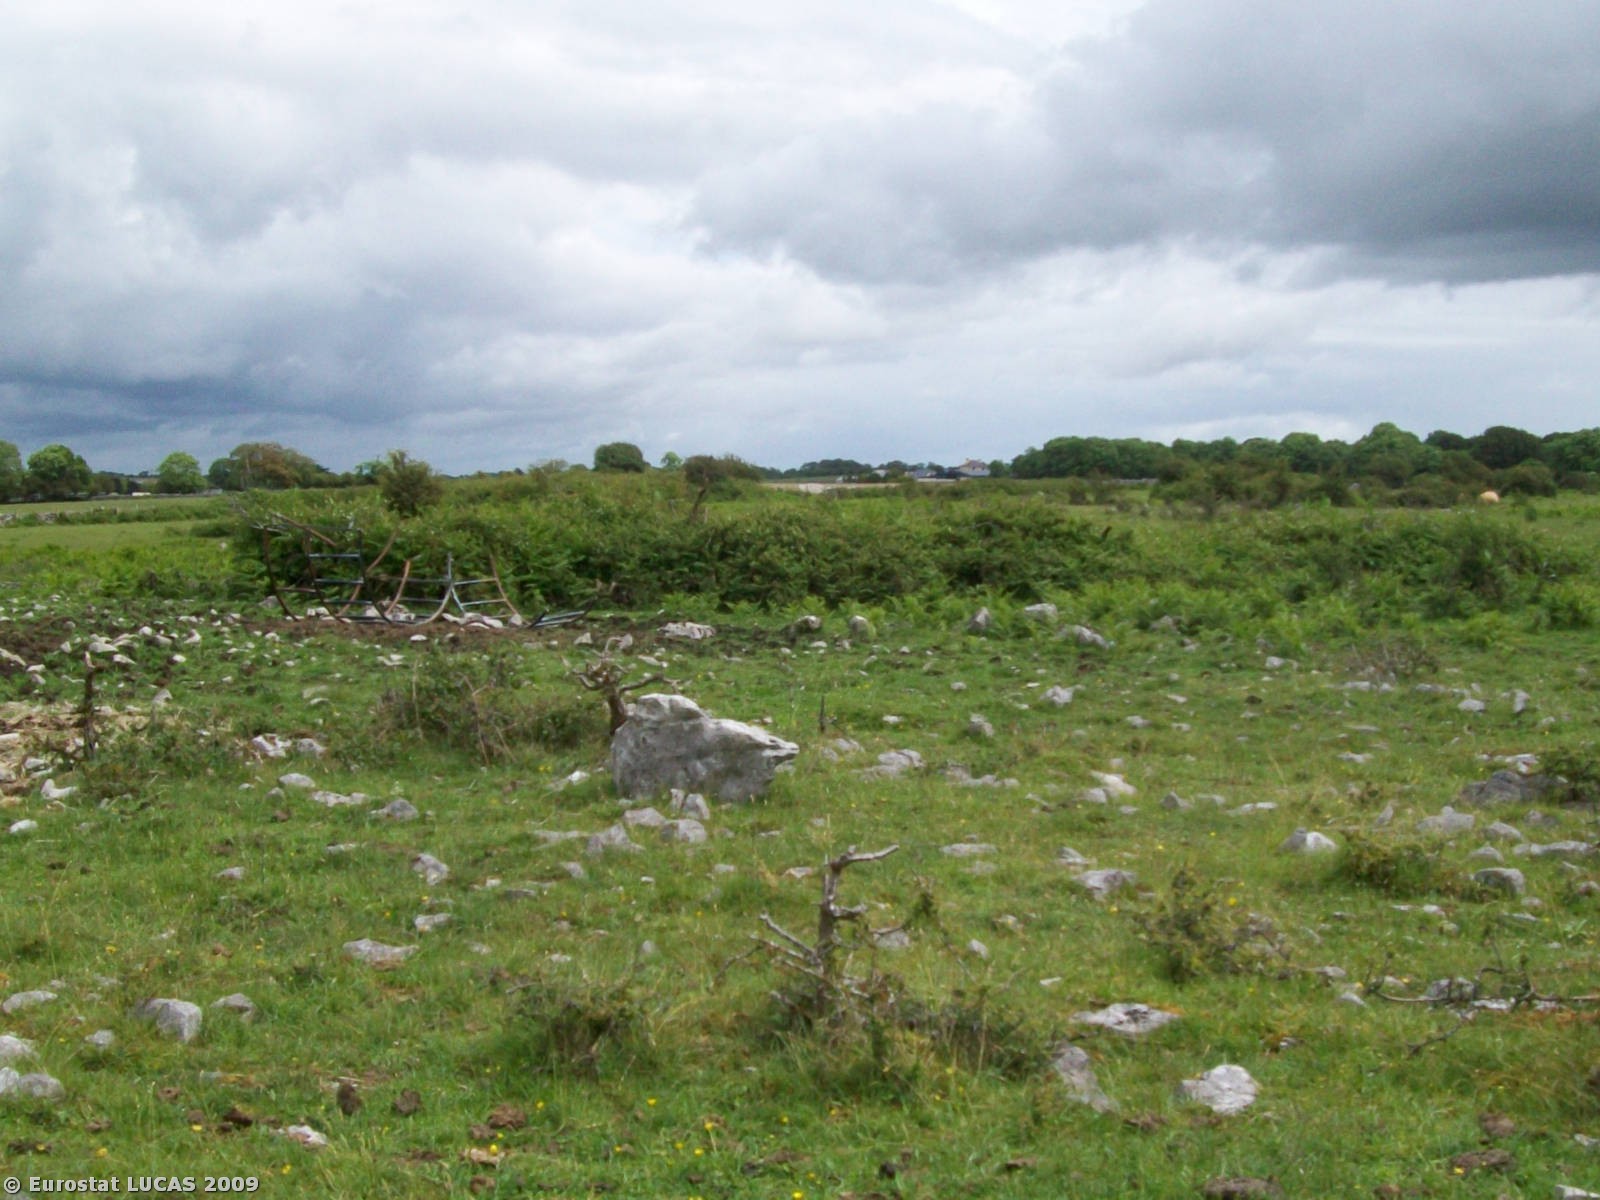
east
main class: Grassland
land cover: Grassland with sparse tree/shrub cover
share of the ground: > 75 %
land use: Agriculture (excluding fallow land and kitchen gardens)
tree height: < 5 m
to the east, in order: Grassland with sparse tree/shrub cover; Tracks; Grassland with sparse tree/shrub cover
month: June
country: IE
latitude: 53.3492
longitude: -8.8179
